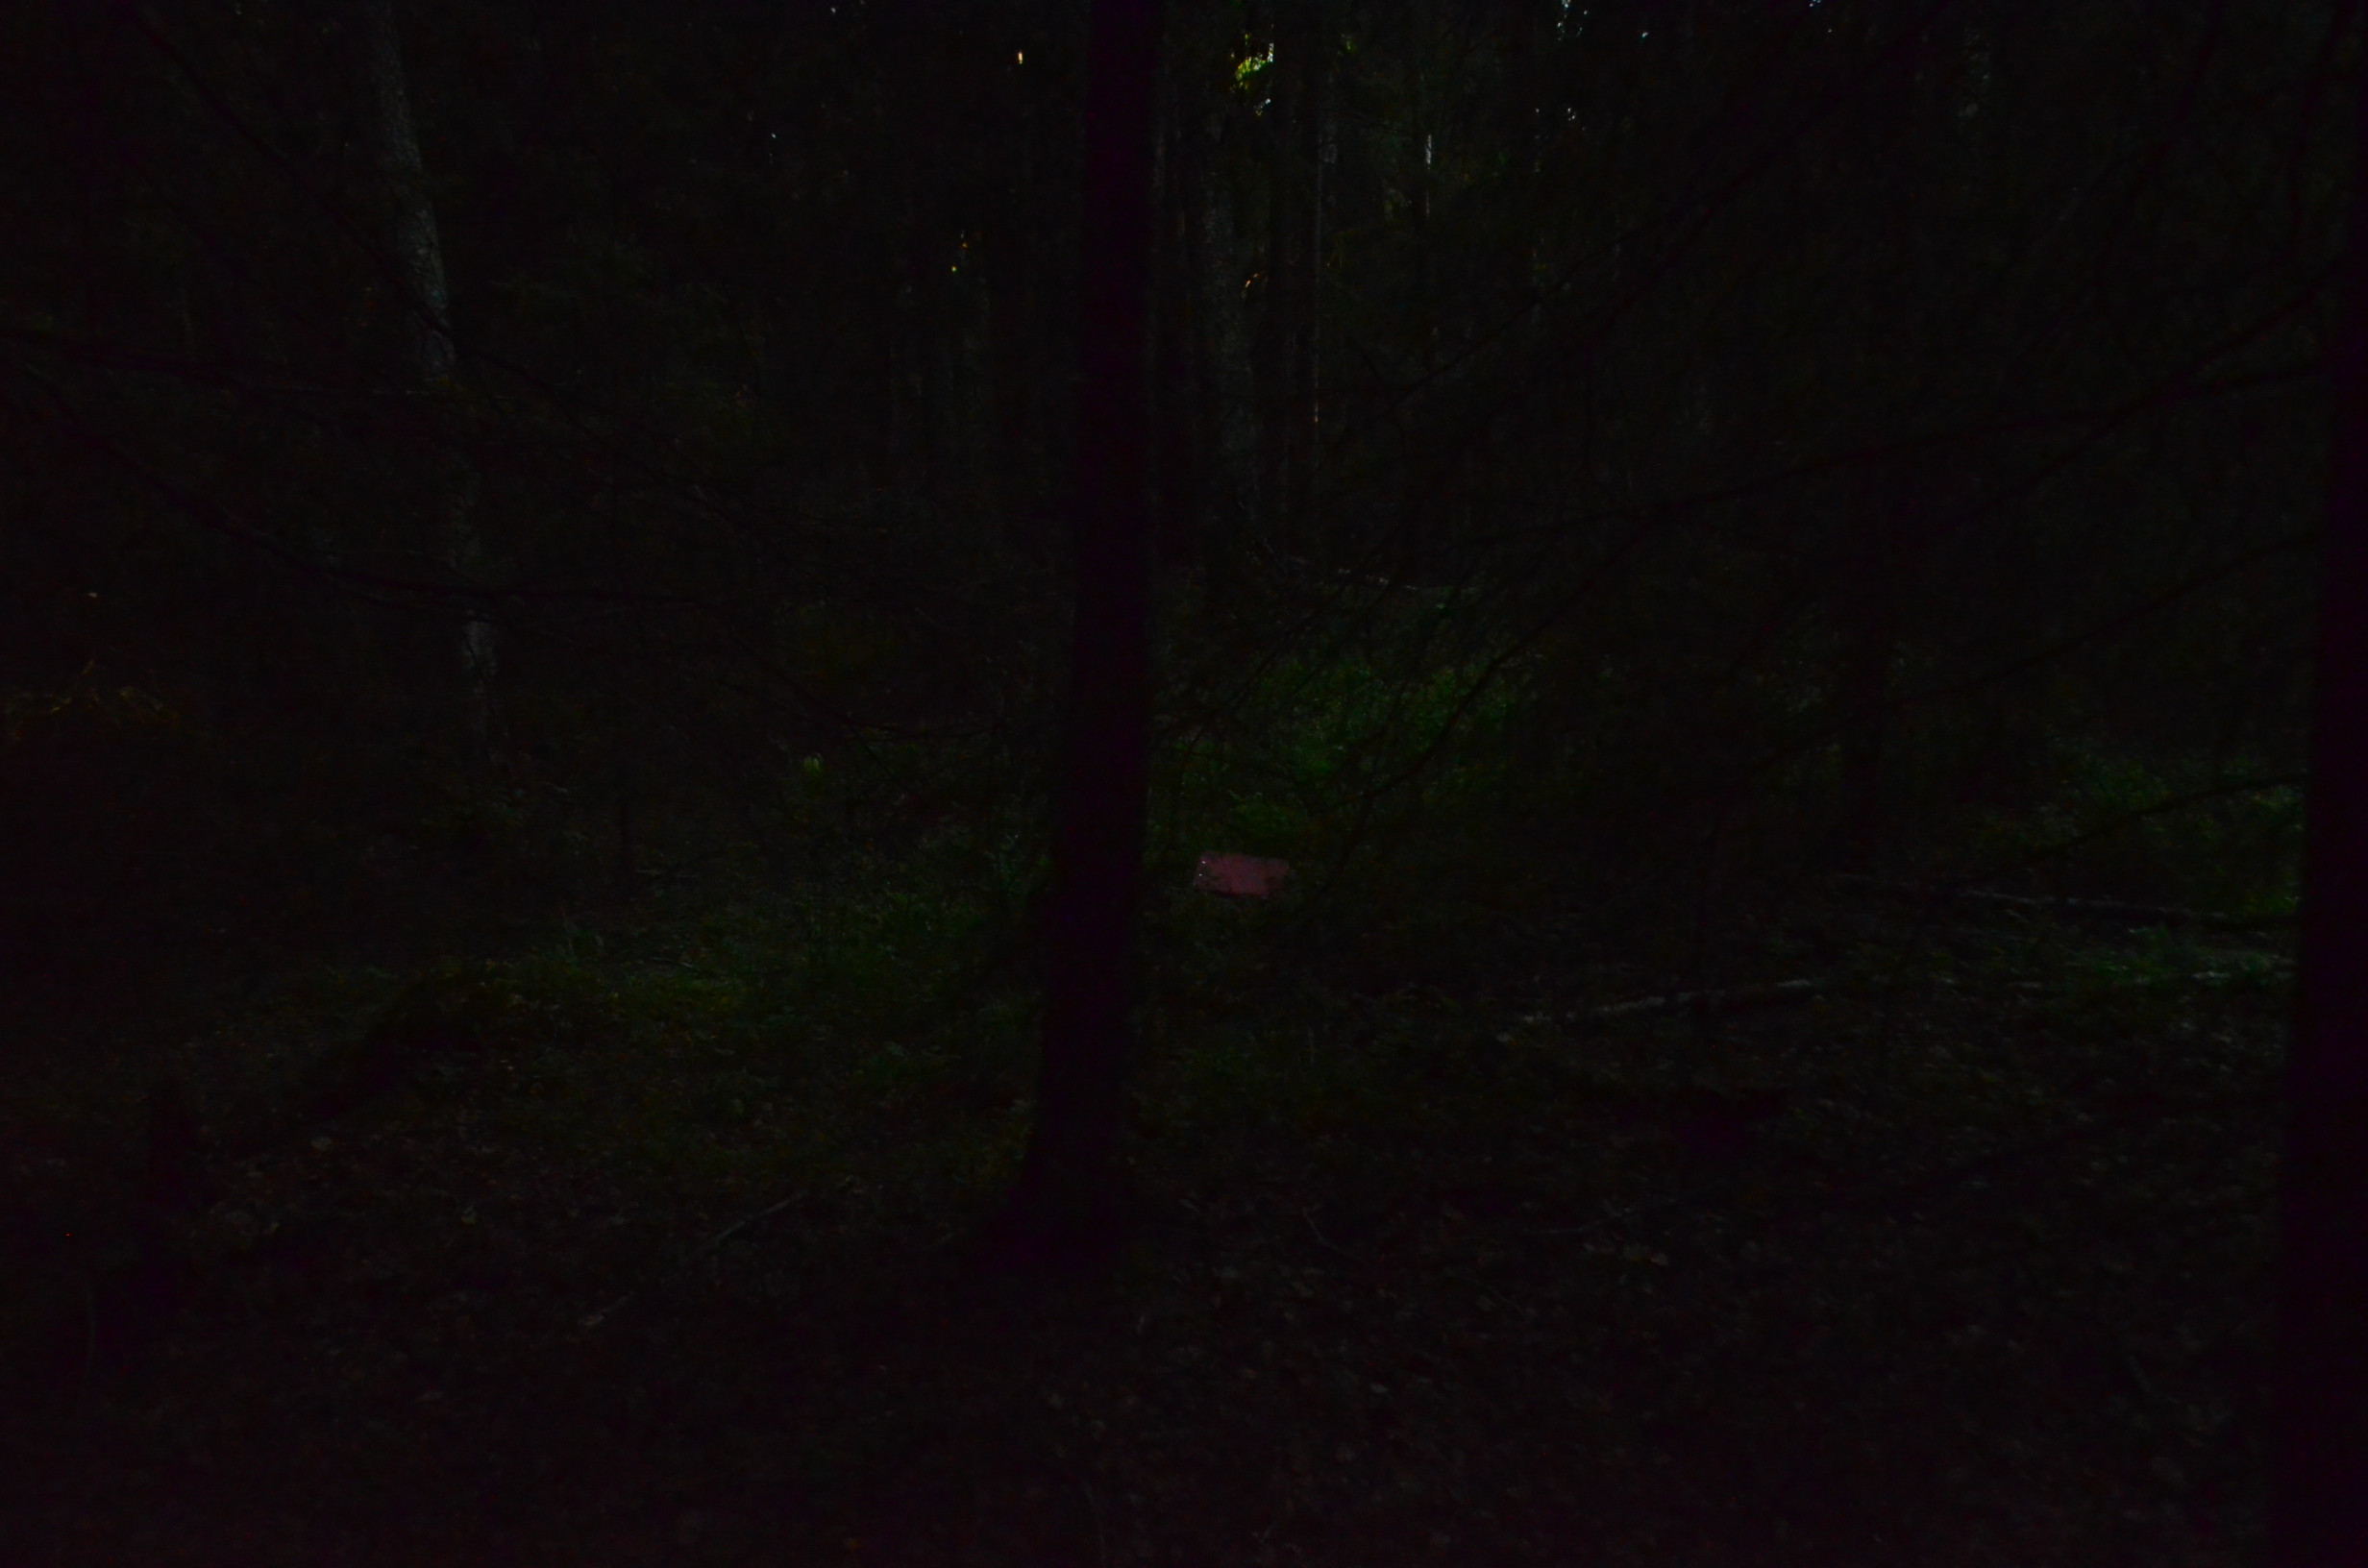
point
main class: Woodland
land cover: Other mixed woodland
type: hemiboreal forest and nemoral coniferous forest and mixed broadleaved-coniferous forest
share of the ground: > 75 %
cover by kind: coniferous forest trees 40 %, broadleaved forest trees 40 %, shrubs 10 %, herbaceous plants 10 %
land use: Forestry
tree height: > 5 m
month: August
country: LV
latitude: 57.5085
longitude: 21.6740
